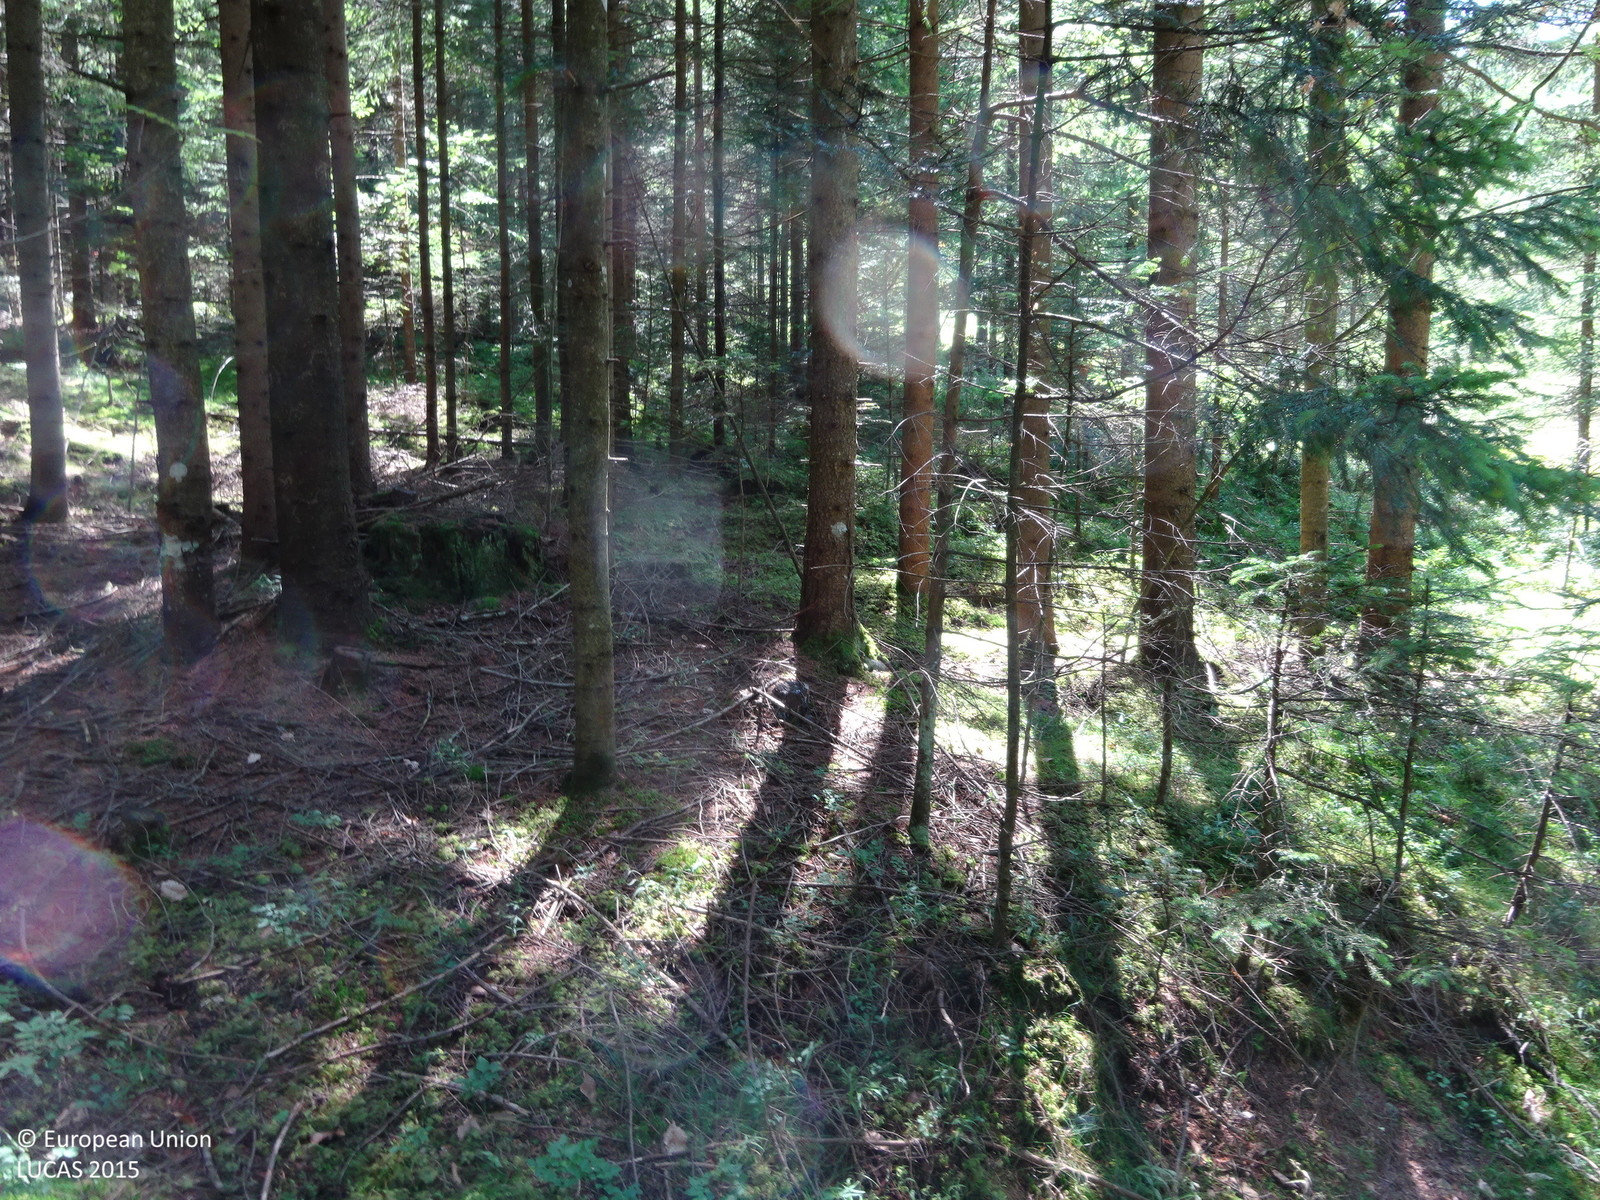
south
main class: Woodland
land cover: Spruce dominated coniferous woodland
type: alpine coniferous forest
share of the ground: > 75 %
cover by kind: coniferous forest trees 100 %
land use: Forestry
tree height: > 5 m
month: August
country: AT
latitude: 47.3347
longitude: 15.7314
